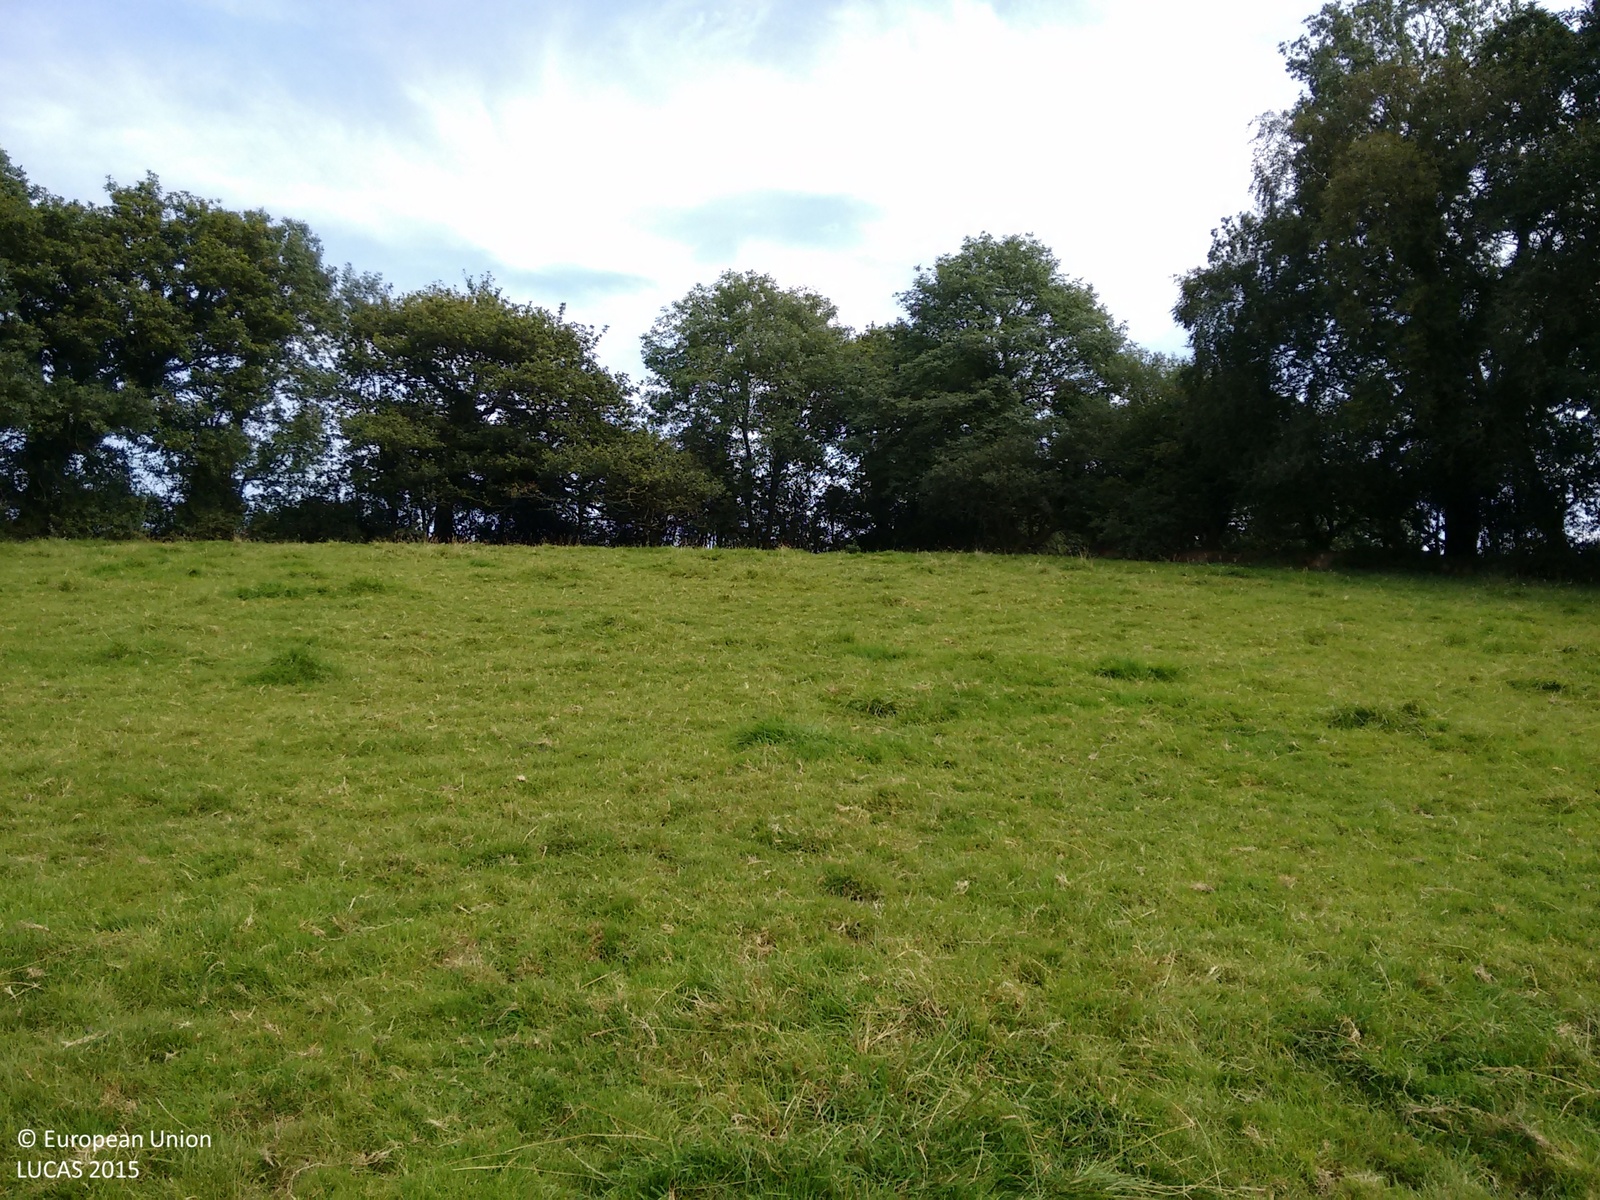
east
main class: Grassland
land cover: Grassland without tree/shrub cover
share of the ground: > 75 %
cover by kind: herbaceous plants 100 %
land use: Agriculture (excluding fallow land and kitchen gardens)
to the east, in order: Grassland without tree/shrub cover; Managed hedges; Broadleaved woodland; Grassland without tree/shrub cover; Managed hedges; Grass margins; Tracks; Grass margins; Managed hedges; Grassland without tree/shrub cover
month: September
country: IE
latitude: 54.4124
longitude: -7.0124
